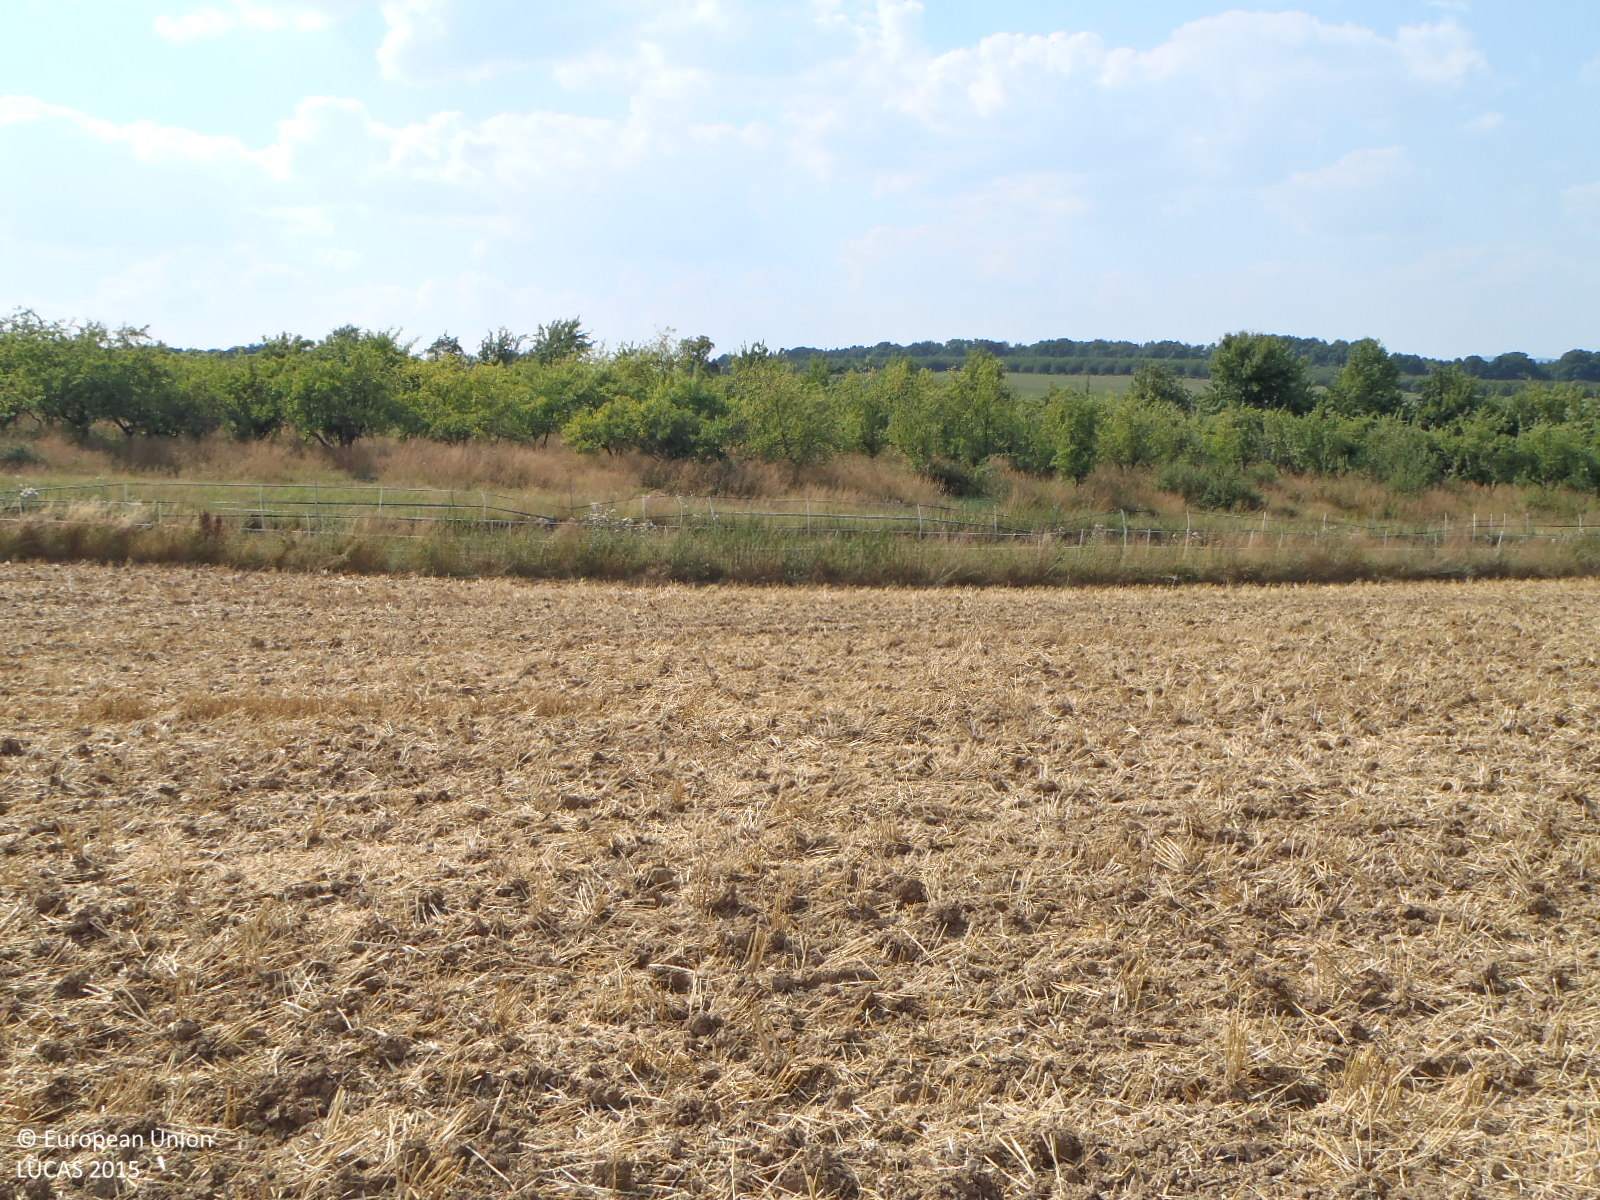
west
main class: Cropland
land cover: Common wheat
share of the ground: 25 - 50 %
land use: Agriculture (excluding fallow land and kitchen gardens)
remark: Harvested field
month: August
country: CZ
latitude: 50.5971
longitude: 14.5651
